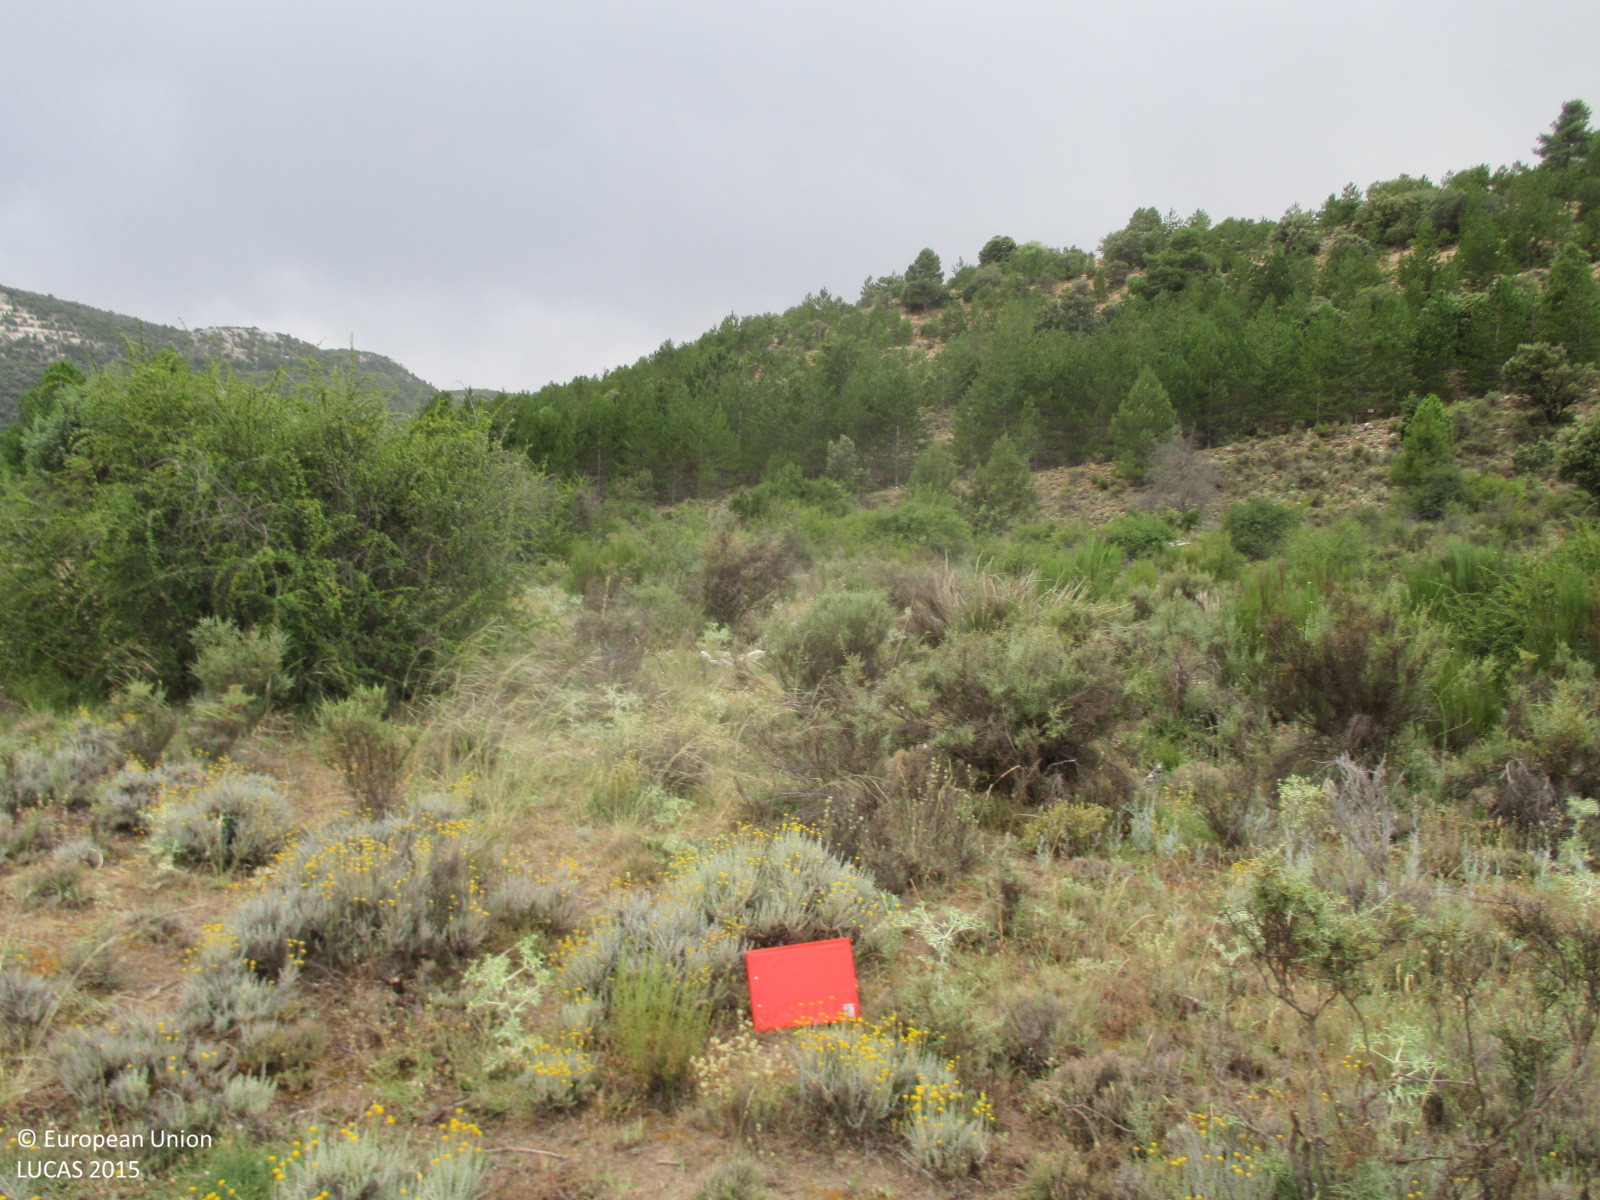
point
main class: Shrubland
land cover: Shrubland without tree cover
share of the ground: 50 - 75 %
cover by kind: shrubs 50 %, herbaceous plants 50 %
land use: Semi-natural and natural areas not in use
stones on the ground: < 10 %
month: July
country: ES
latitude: 38.1243
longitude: -2.3929
